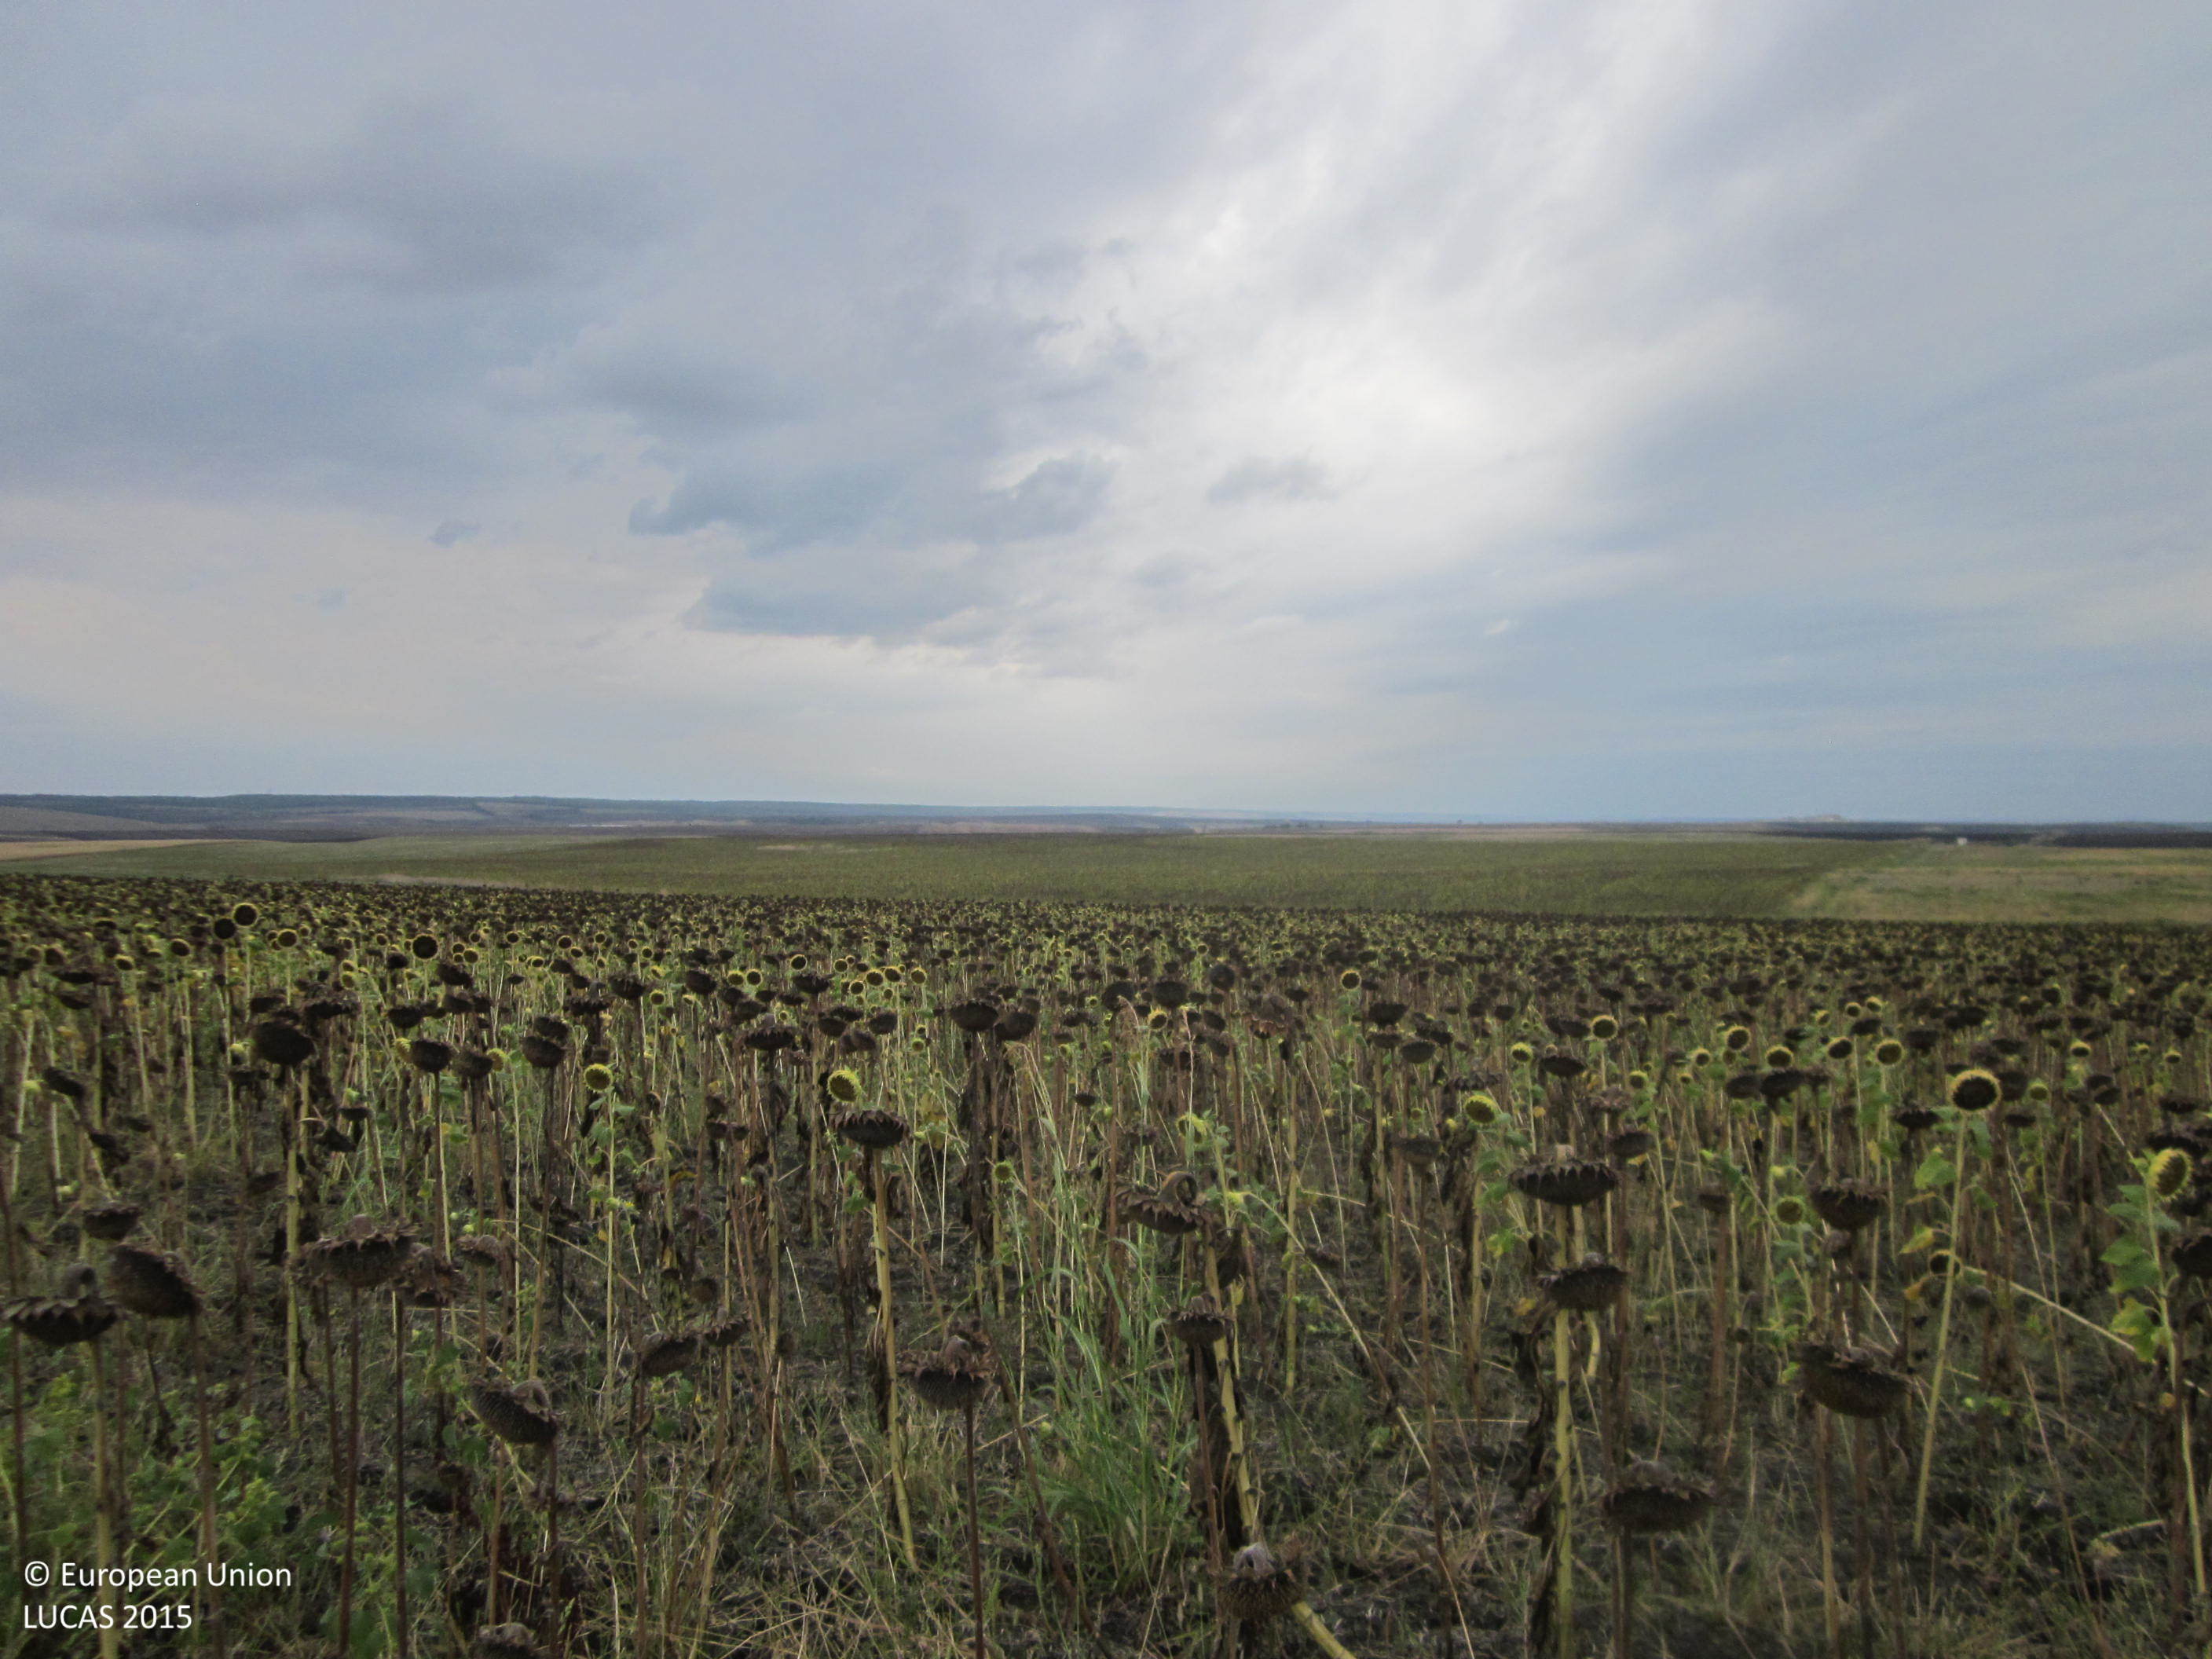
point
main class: Cropland
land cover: Sunflower
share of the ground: > 75 %
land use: Agriculture (excluding fallow land and kitchen gardens)
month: September
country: BG
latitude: 42.4734
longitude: 27.2239
